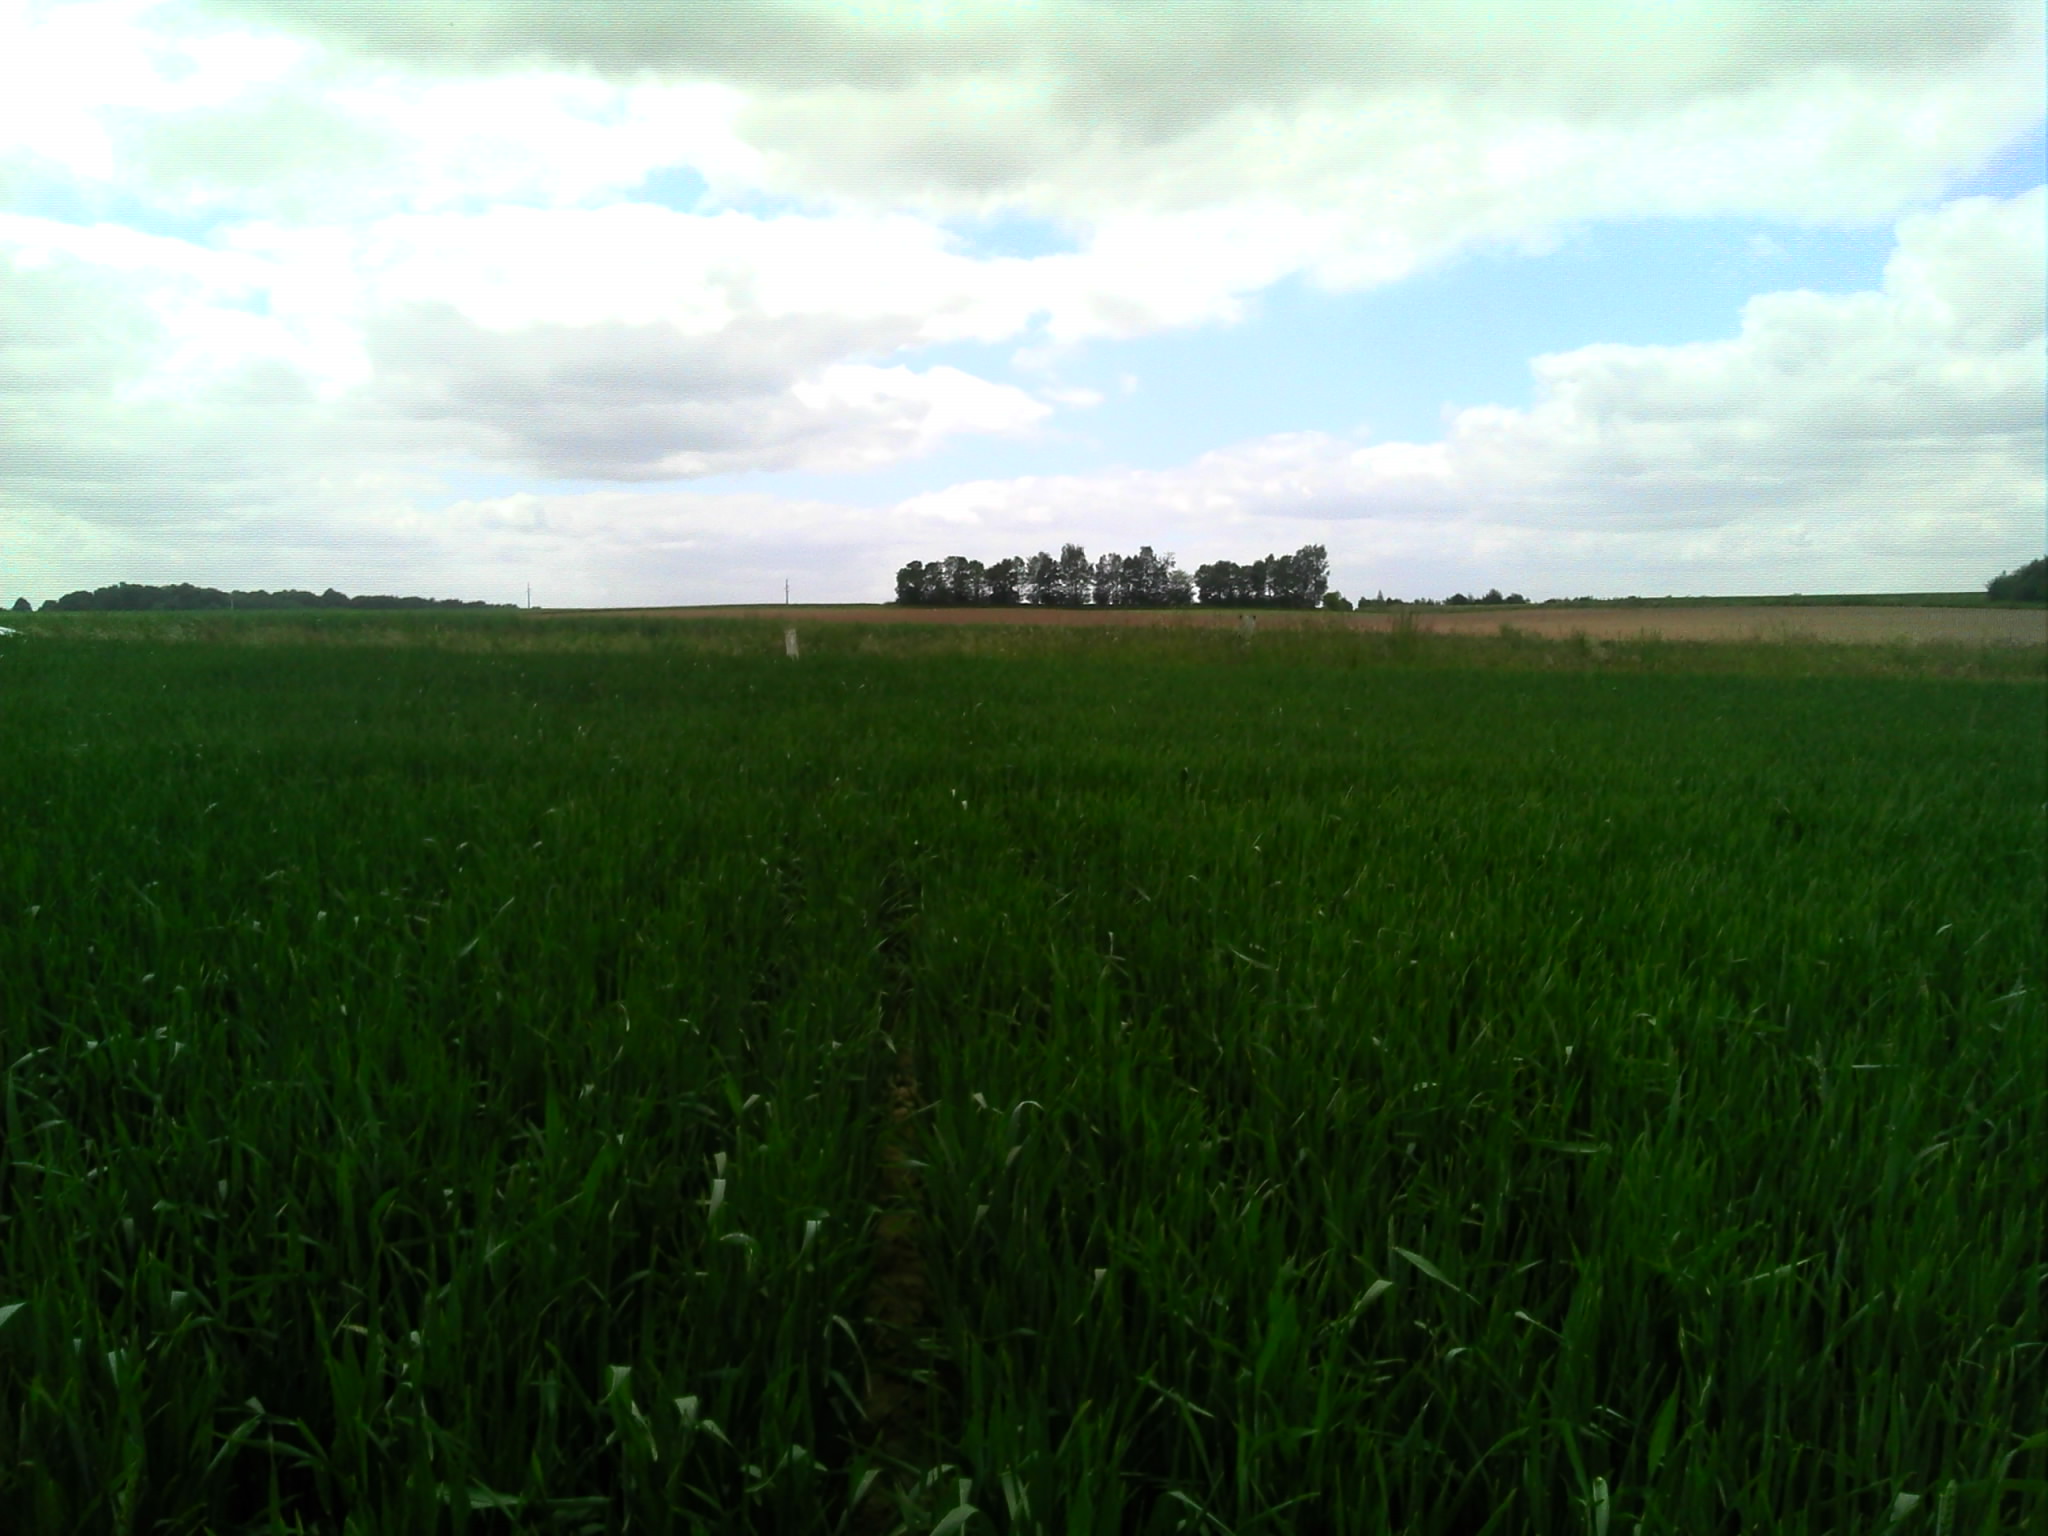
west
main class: Cropland
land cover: Common wheat
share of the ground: > 75 %
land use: Agriculture (excluding fallow land and kitchen gardens)
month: June
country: BE
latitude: 50.4914
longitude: 4.6540
